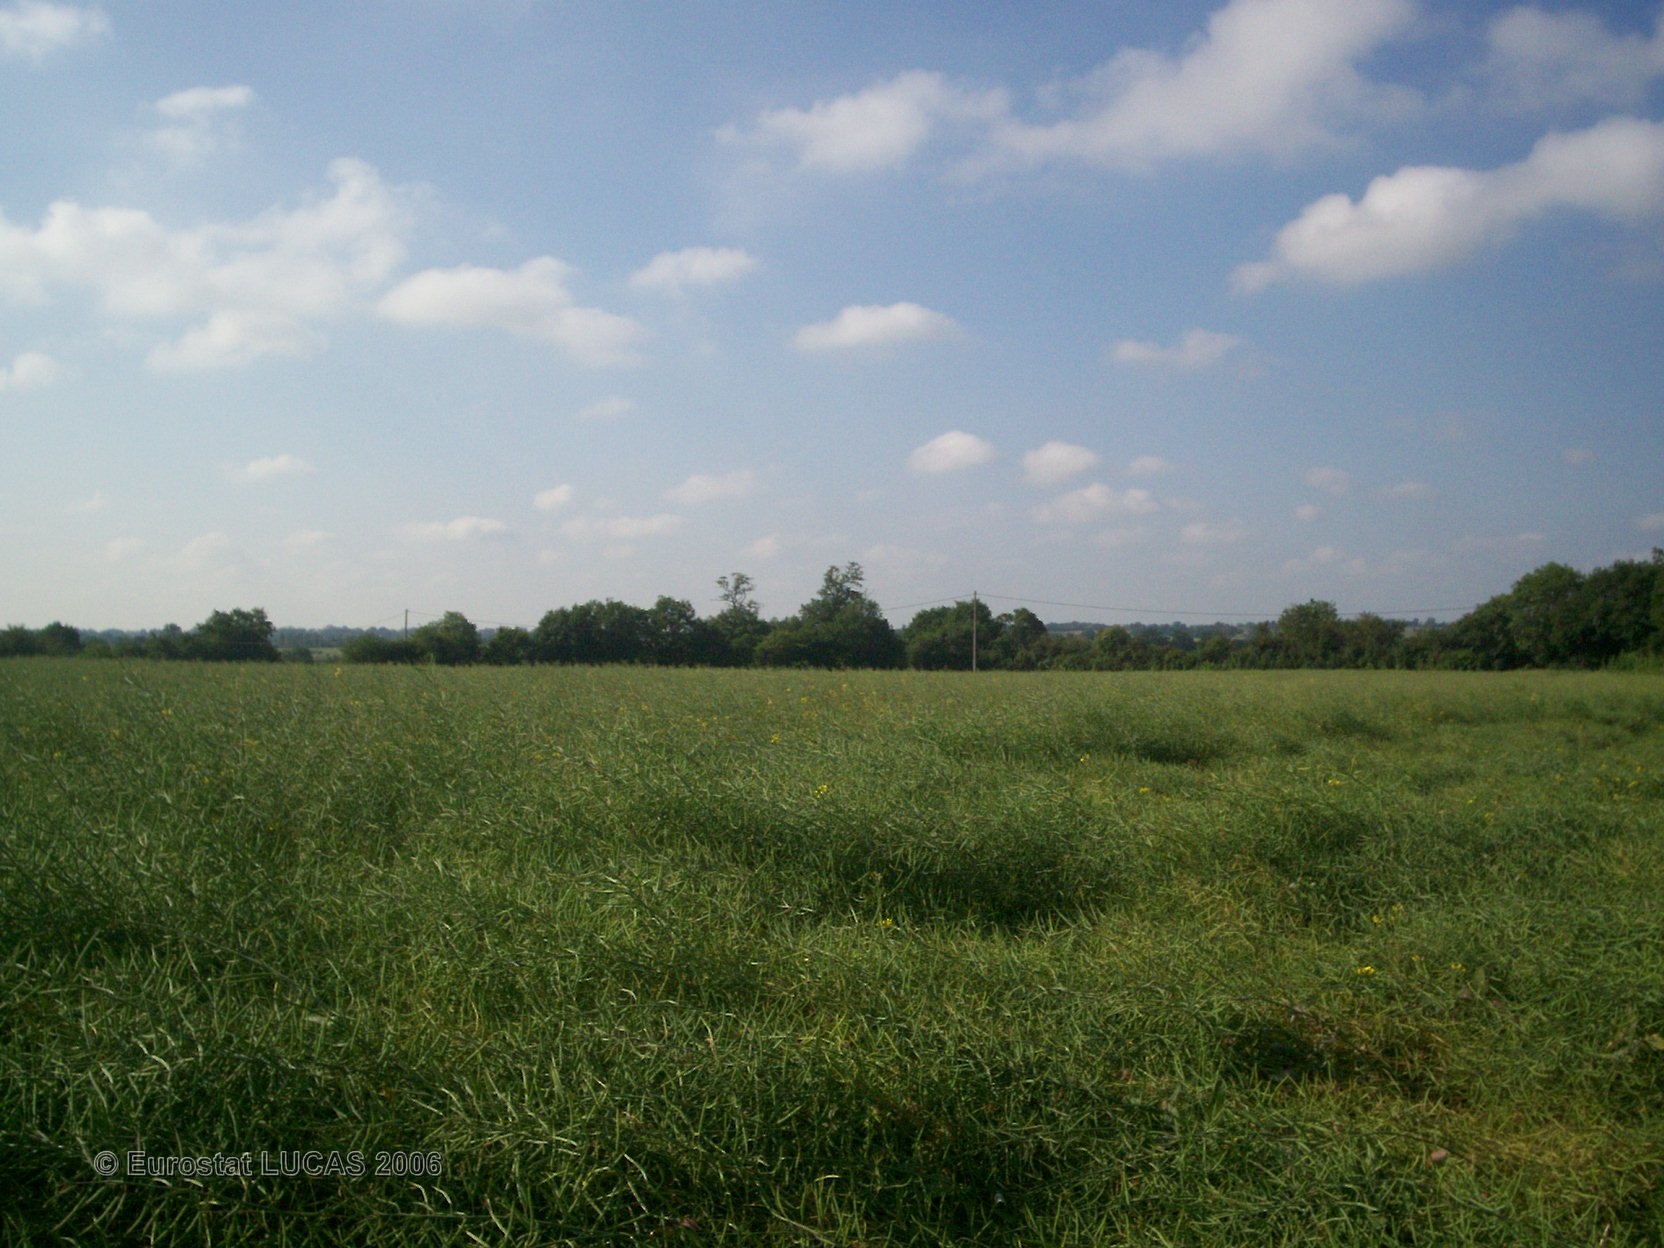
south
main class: Cropland
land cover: Rape and turnip rape
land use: Agriculture (excluding fallow land and kitchen gardens)
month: June
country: FR
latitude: 48.0361
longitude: -0.6165
